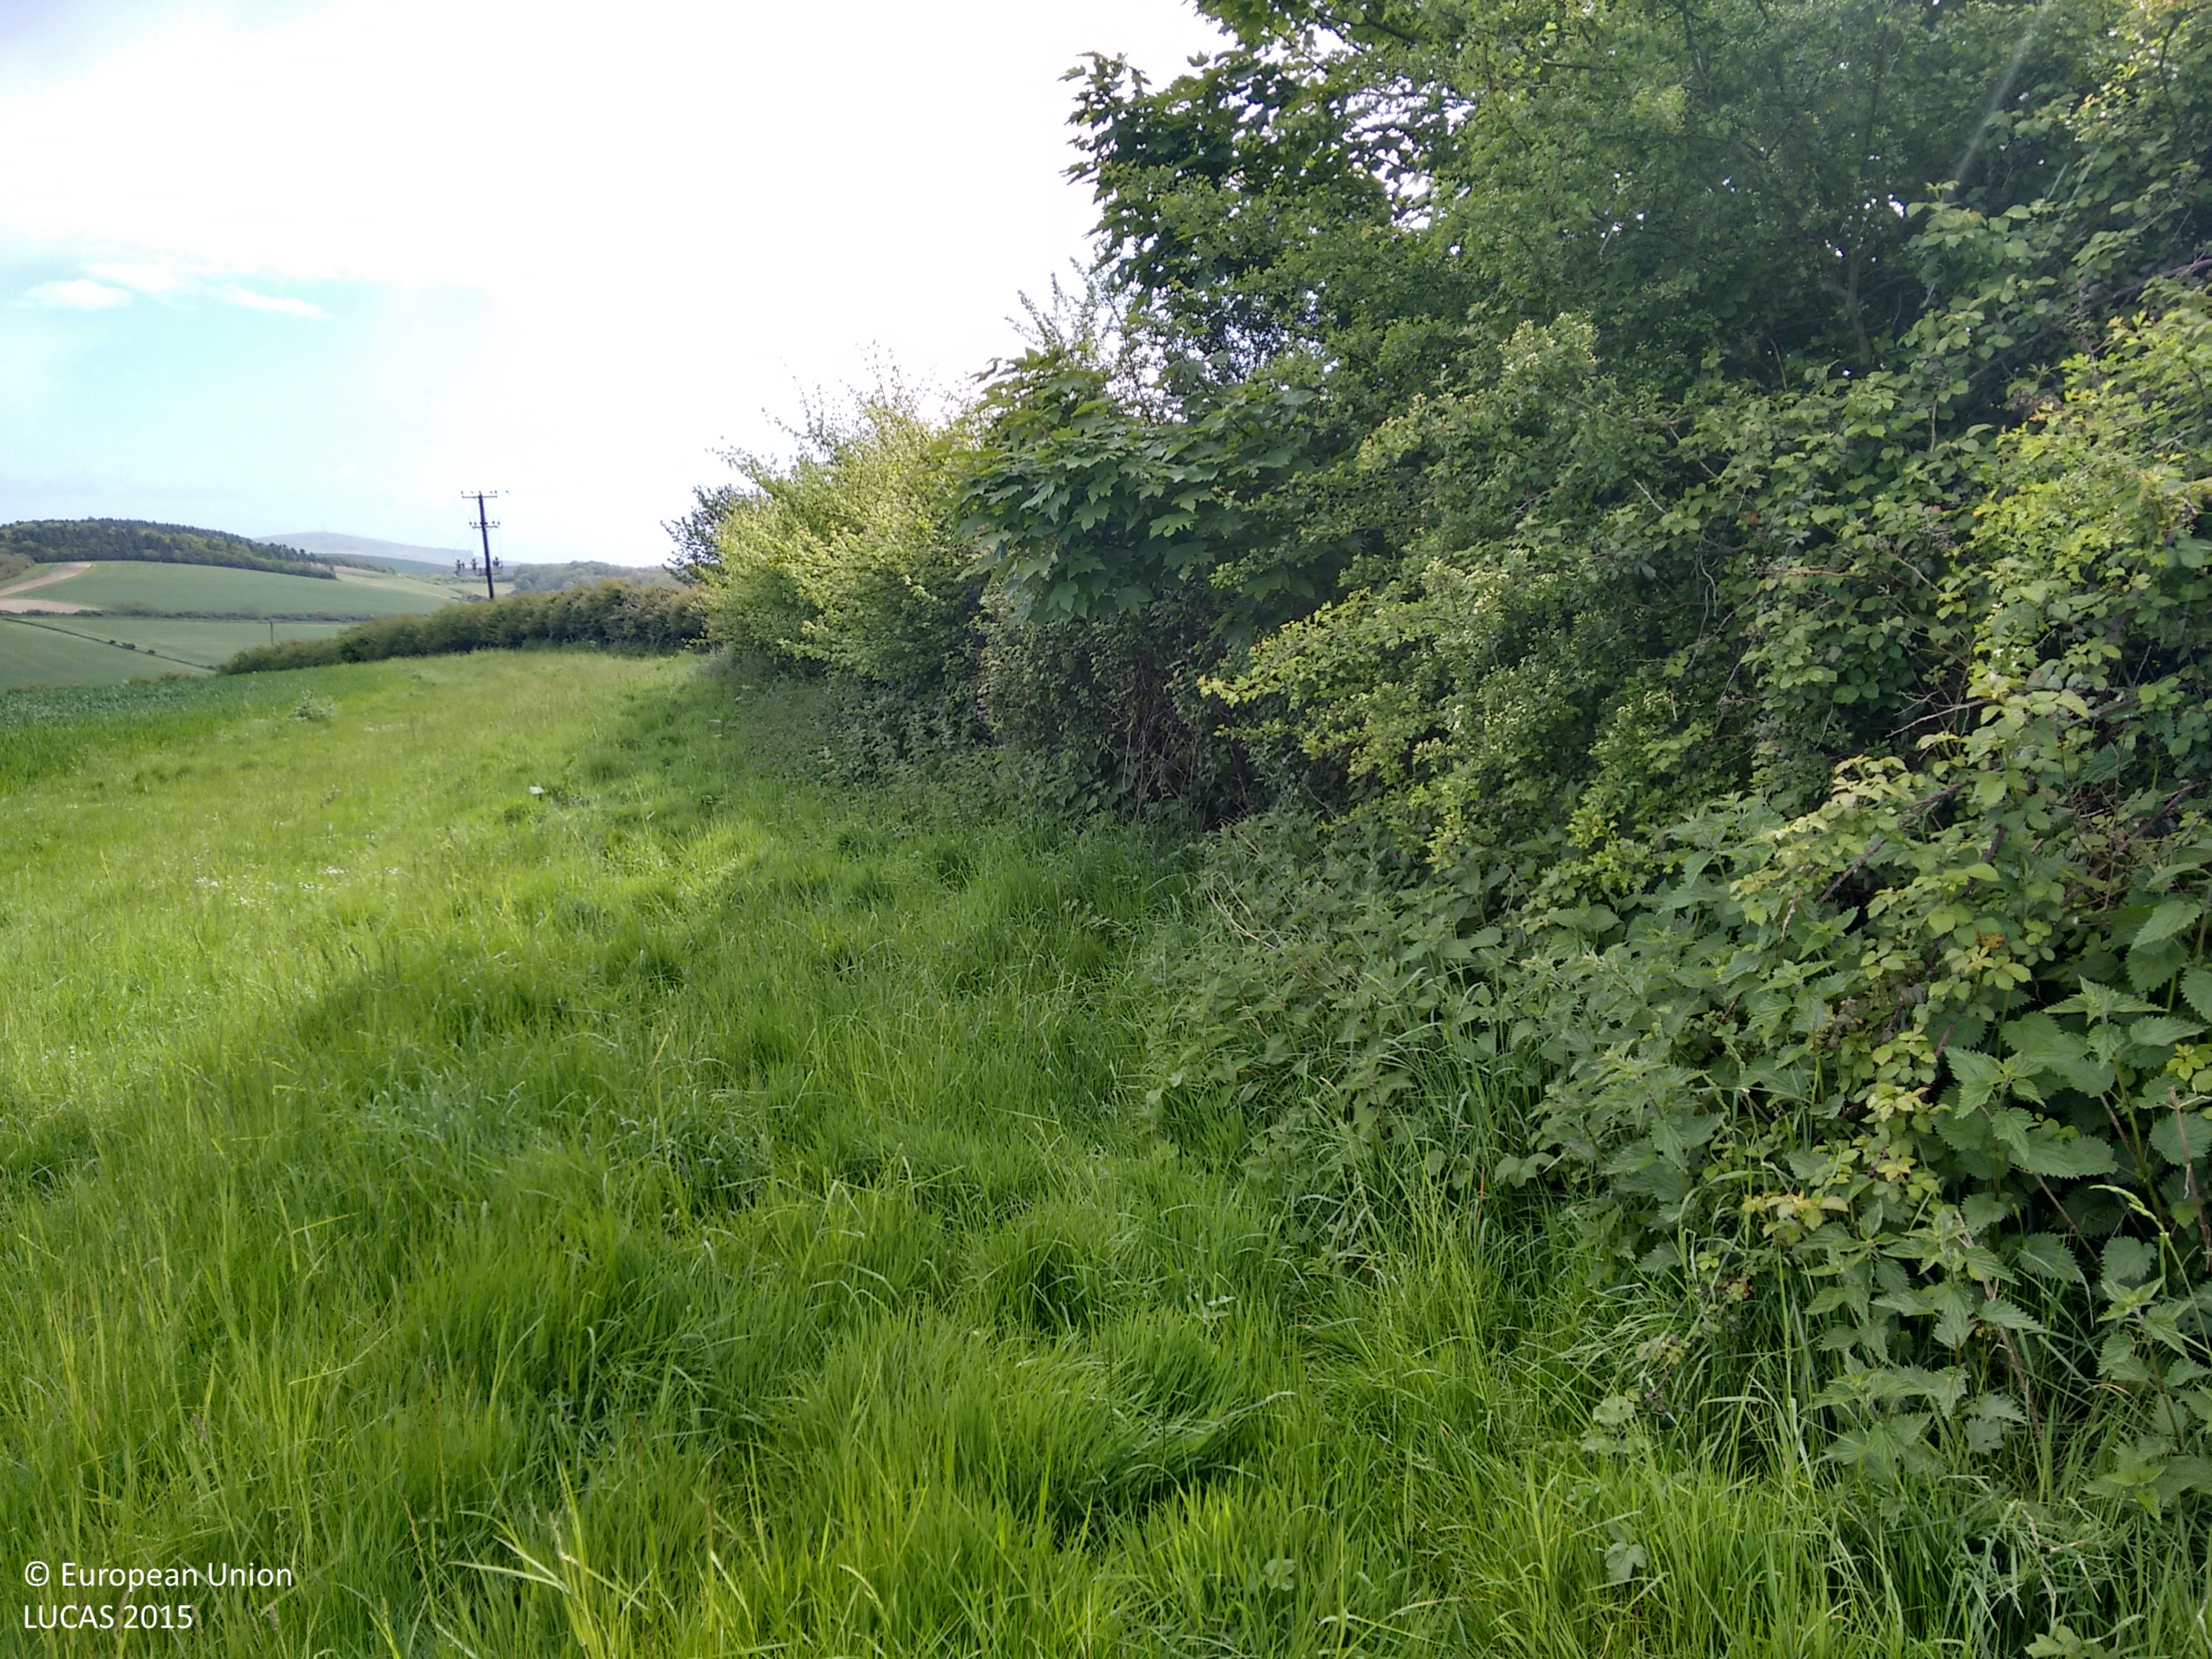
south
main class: Grassland
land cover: Grassland without tree/shrub cover
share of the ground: > 75 %
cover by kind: herbaceous plants 100 %
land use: Agriculture (excluding fallow land and kitchen gardens)
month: May
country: GB
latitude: 50.6684
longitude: -1.3537
